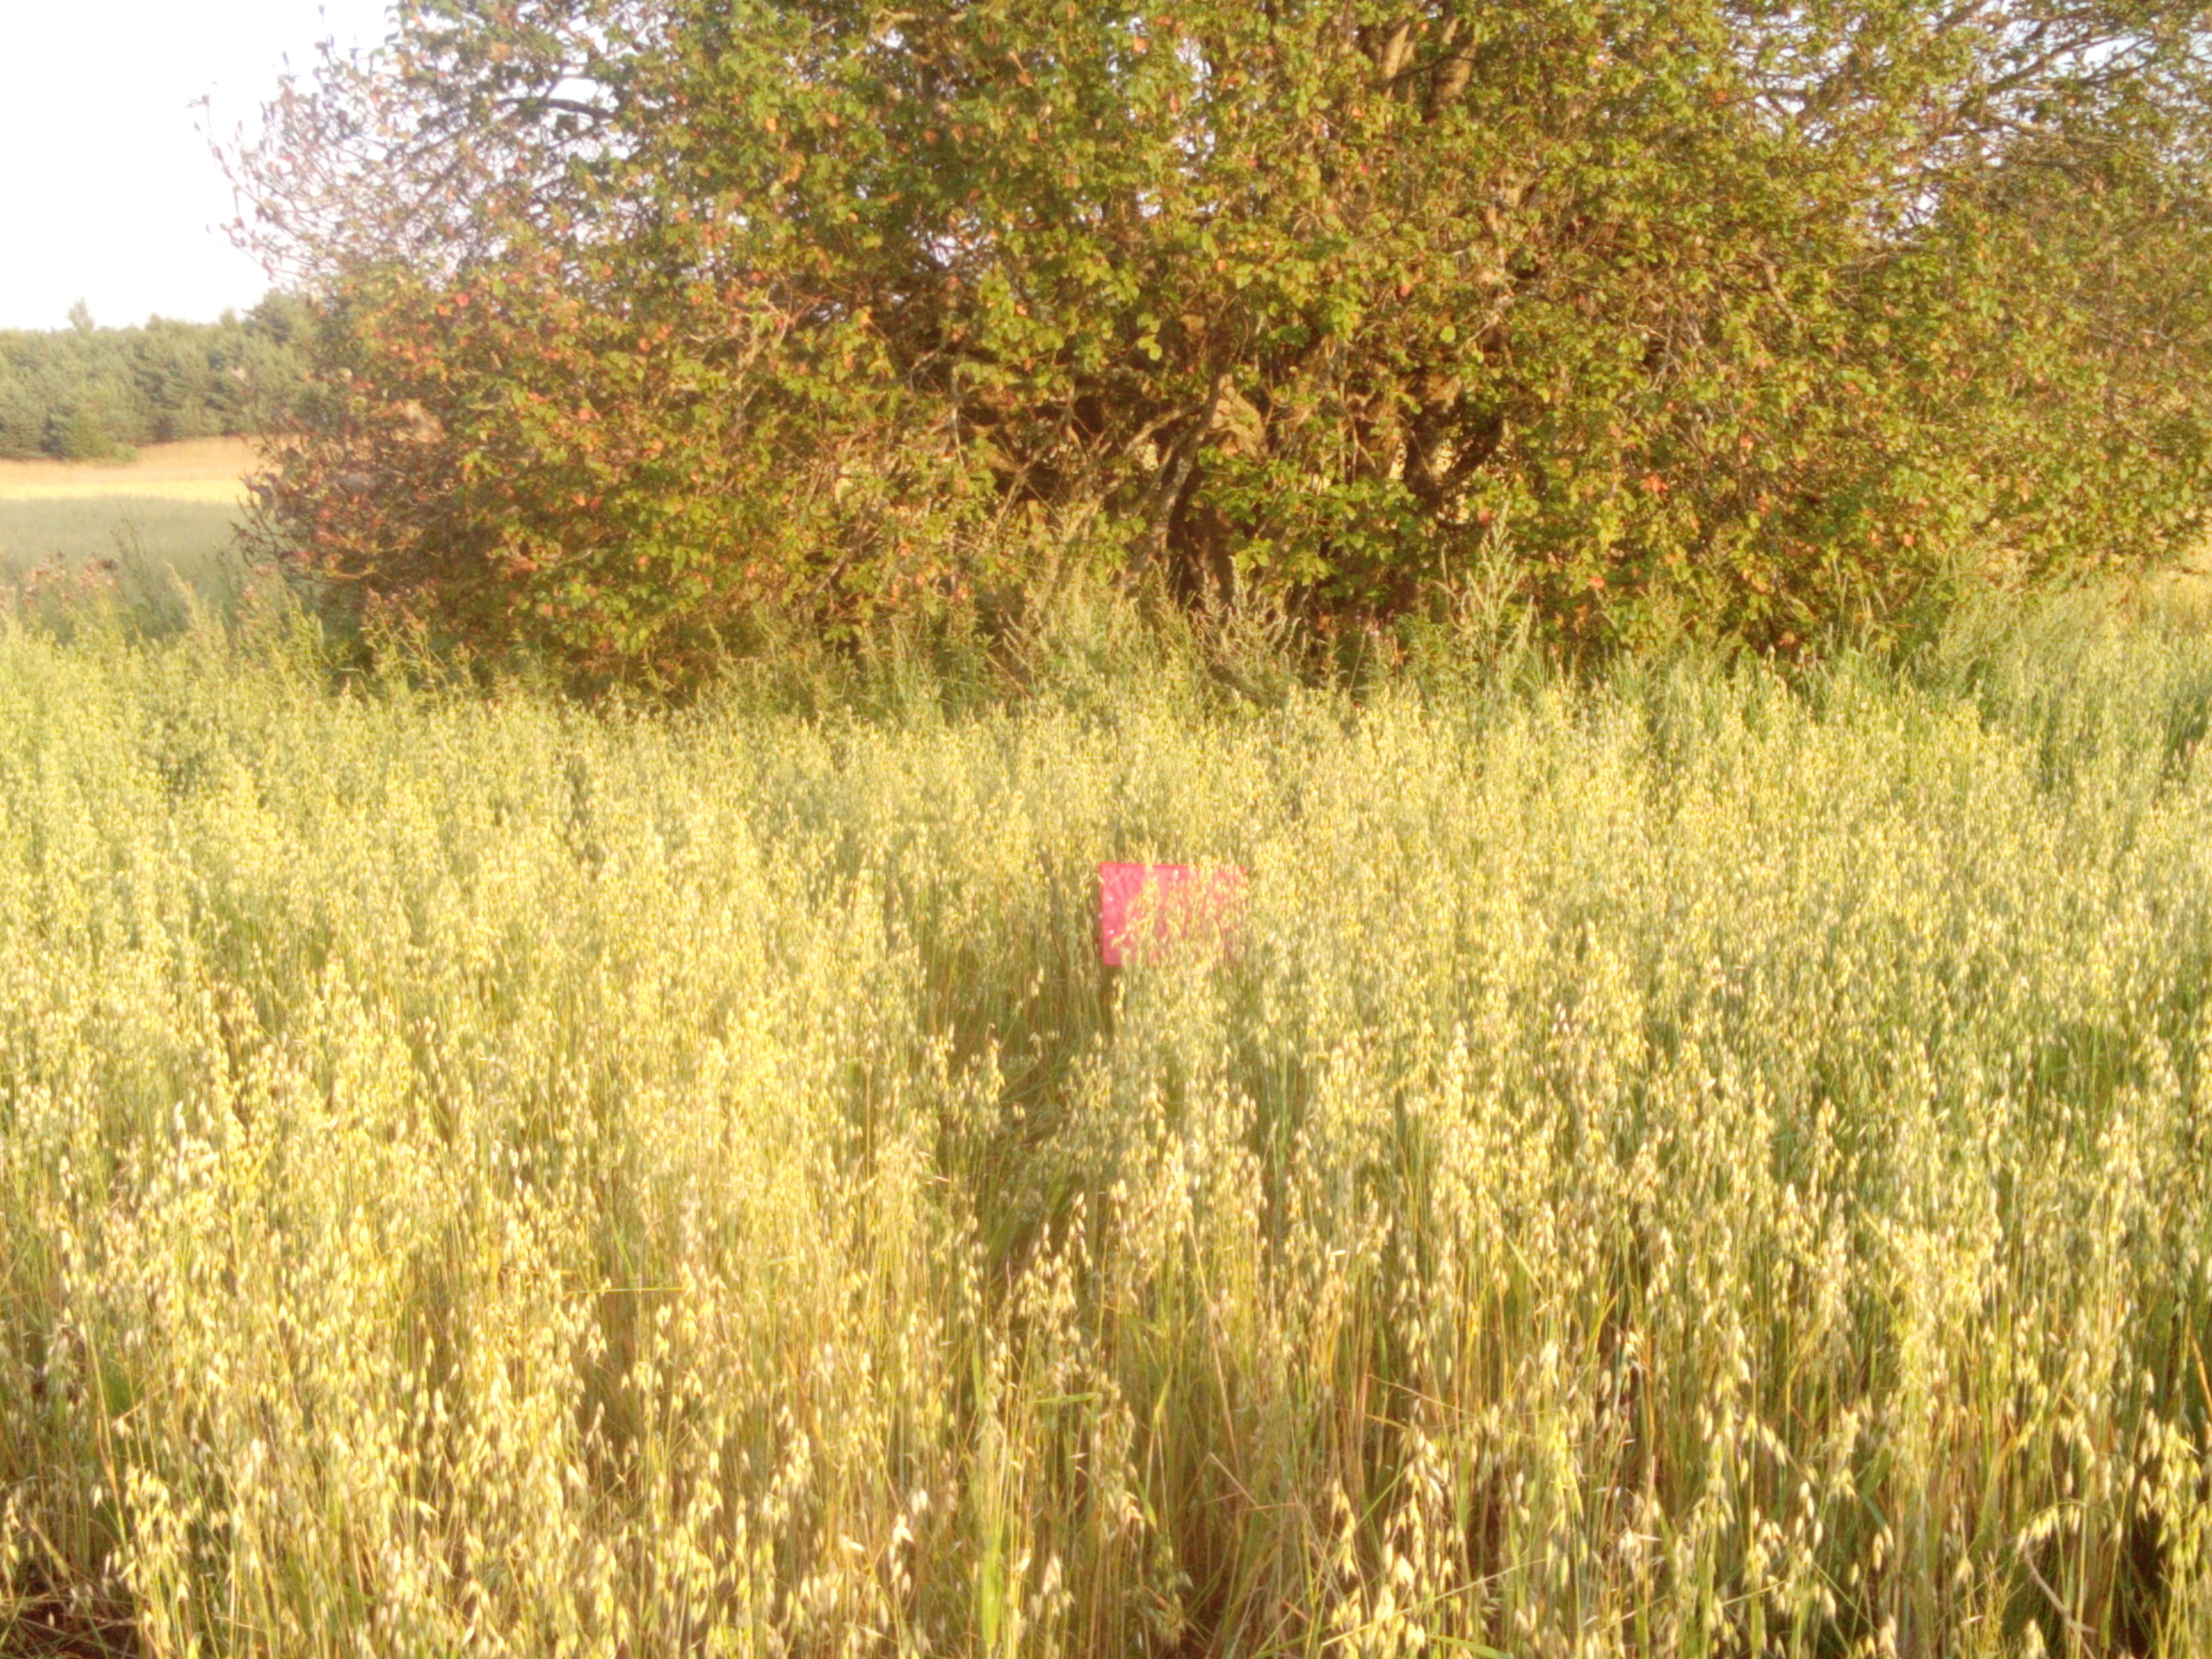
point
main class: Cropland
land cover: Oats
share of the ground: > 75 %
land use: Agriculture (excluding fallow land and kitchen gardens)
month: August
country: LV
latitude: 56.9777
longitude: 21.7082
